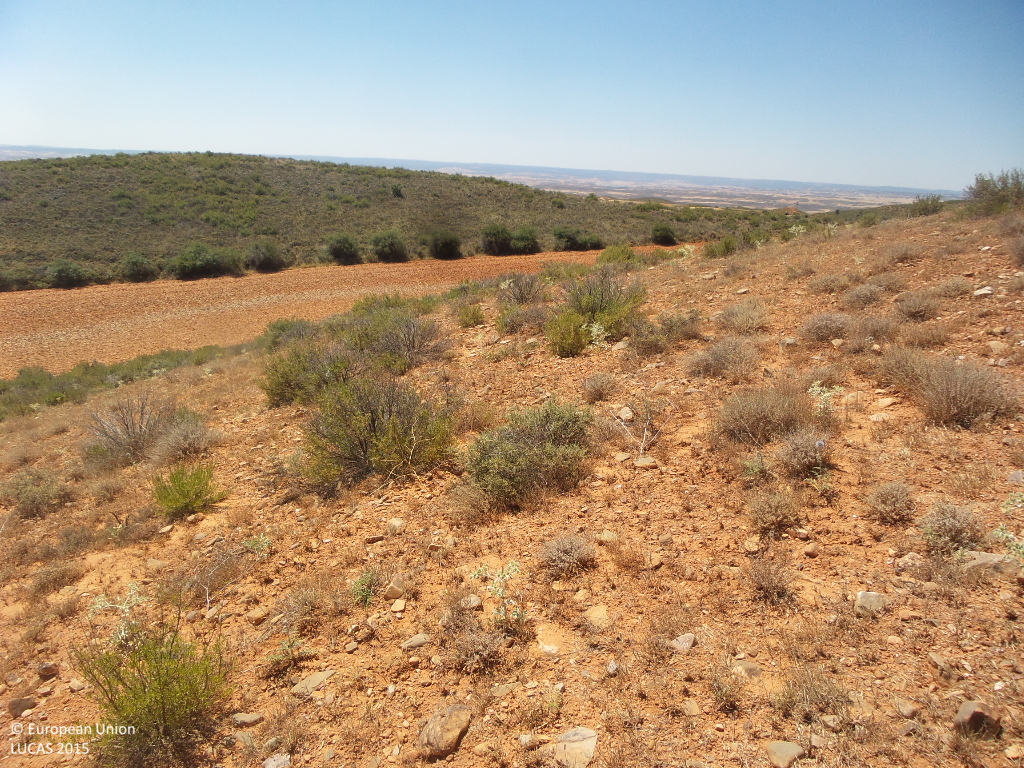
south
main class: Shrubland
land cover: Shrubland without tree cover
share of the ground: 25 - 50 %
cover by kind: unconsolidated bare surface 50 %, shrubs 40 %, herbaceous plants 10 %
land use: Semi-natural and natural areas not in use
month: July
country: ES
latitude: 41.3761
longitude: -2.1183
